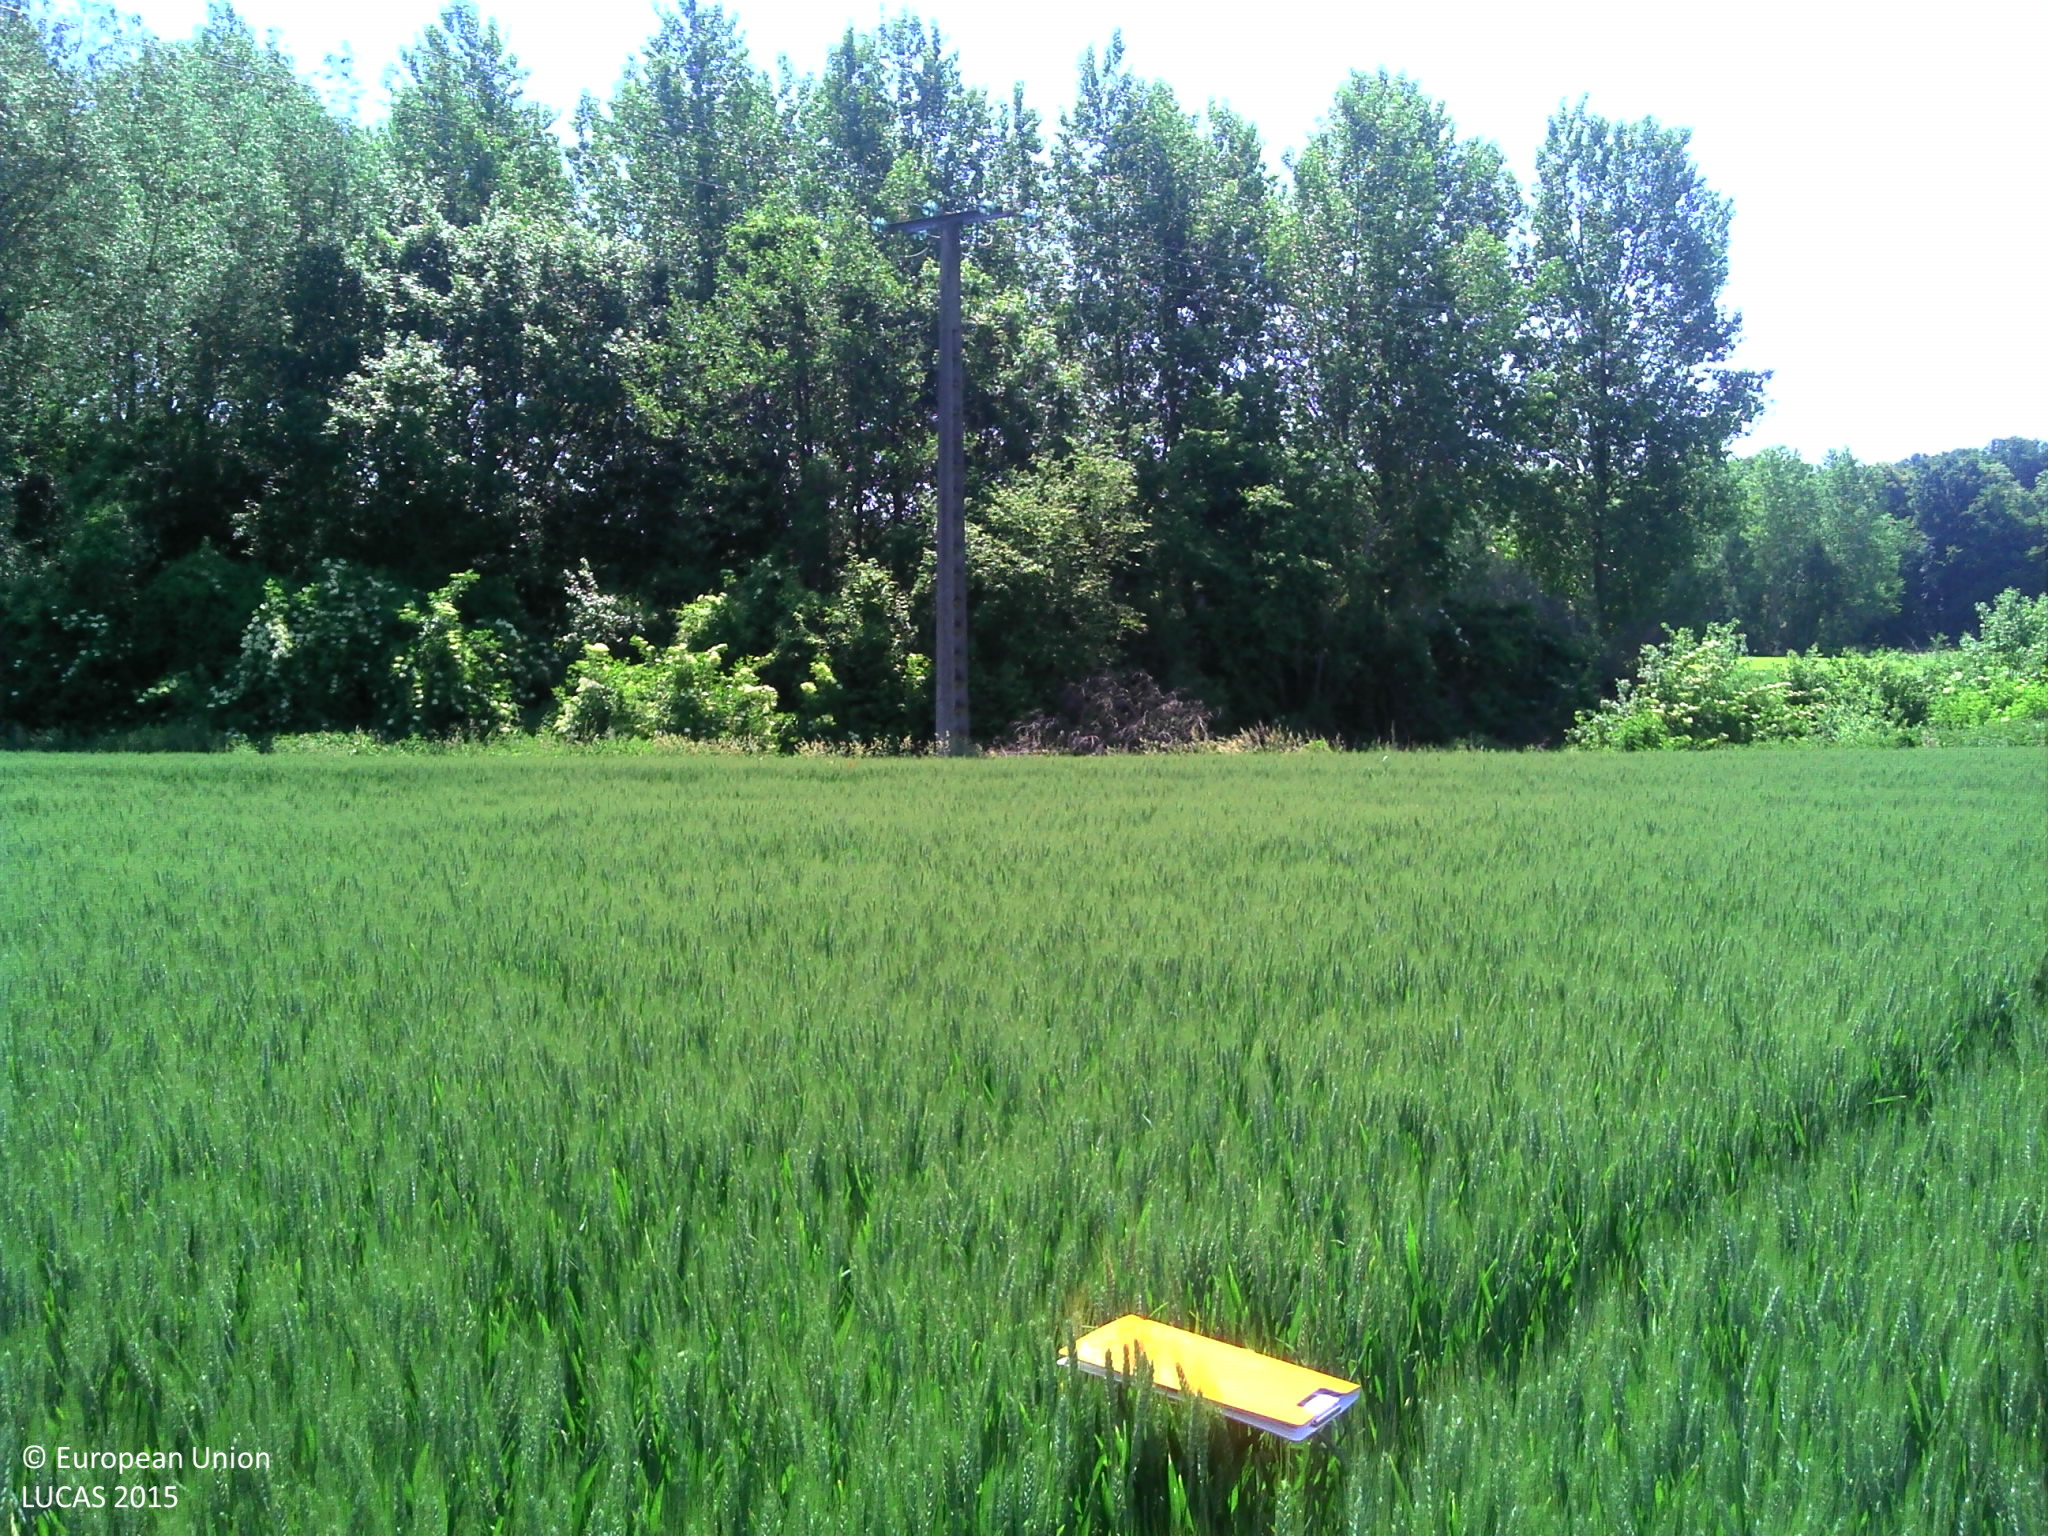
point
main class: Cropland
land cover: Common wheat
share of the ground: > 75 %
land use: Agriculture (excluding fallow land and kitchen gardens)
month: June
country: FR
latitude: 49.5695
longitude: 3.2577
